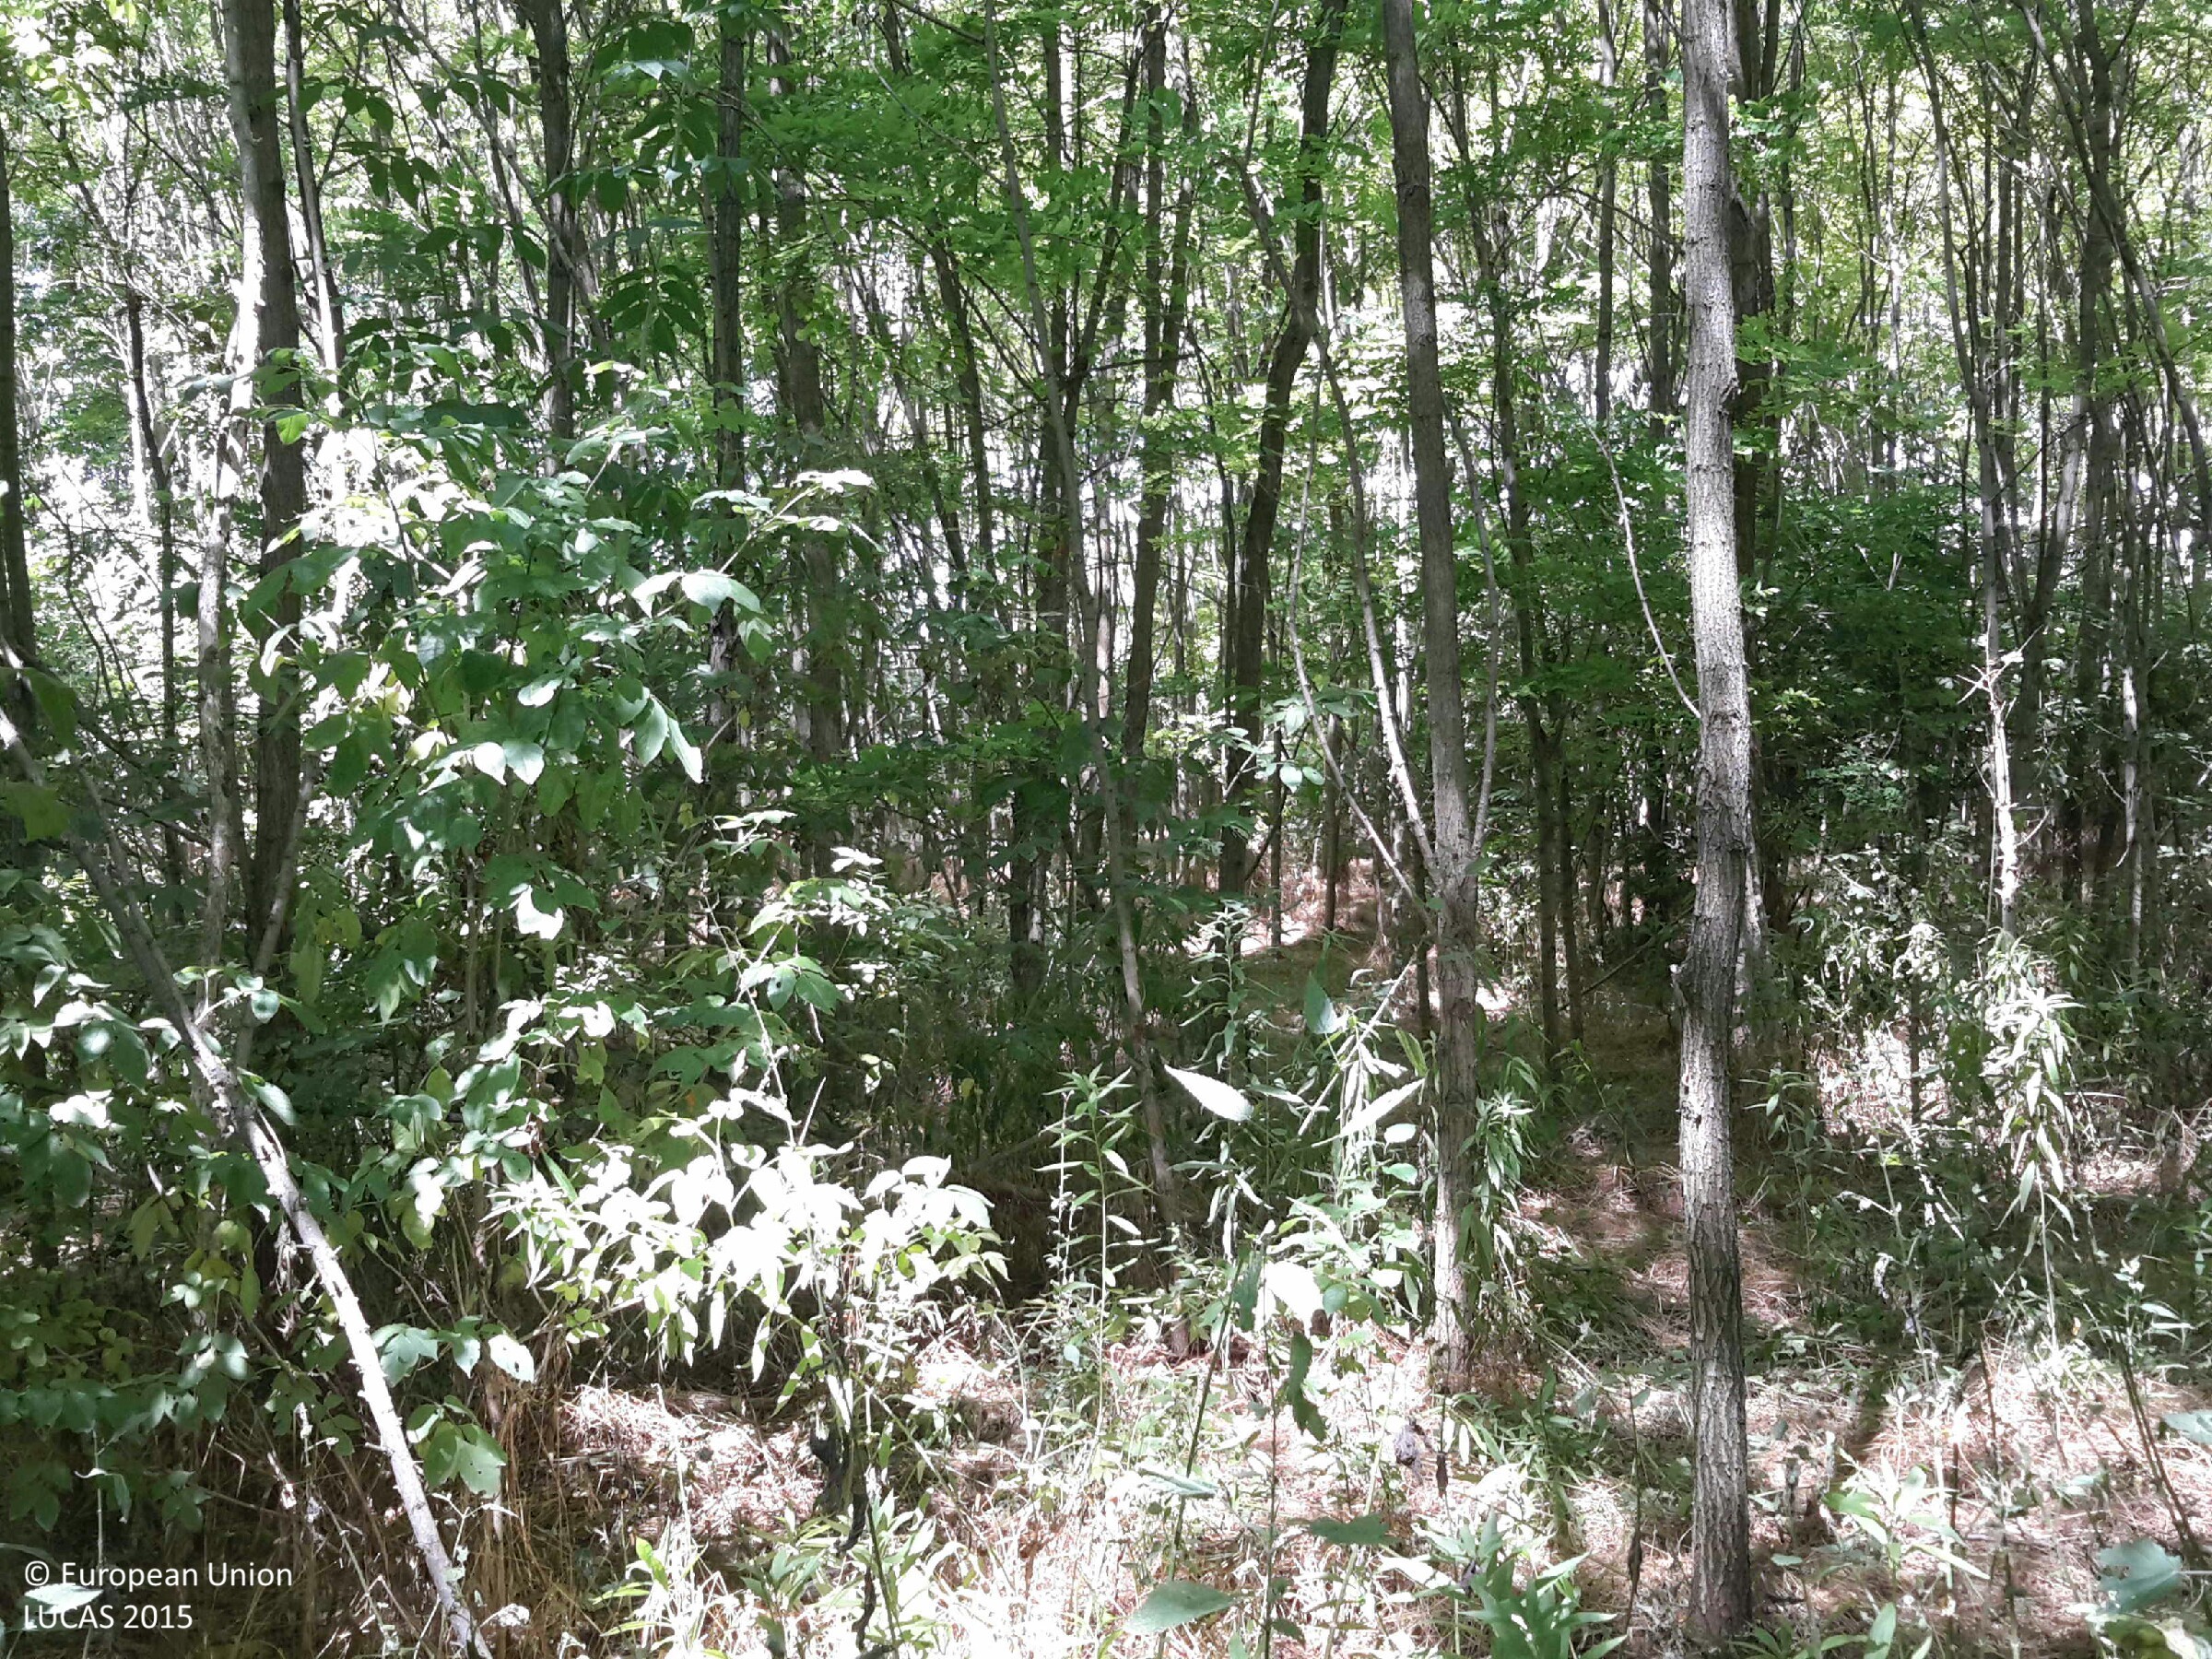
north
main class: Woodland
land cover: Broadleaved woodland
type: exotic forest
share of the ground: > 75 %
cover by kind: broadleaved forest trees 90 %, herbaceous plants 10 %
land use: Forestry
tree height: > 5 m
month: July
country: HU
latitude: 47.7640
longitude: 17.5741
